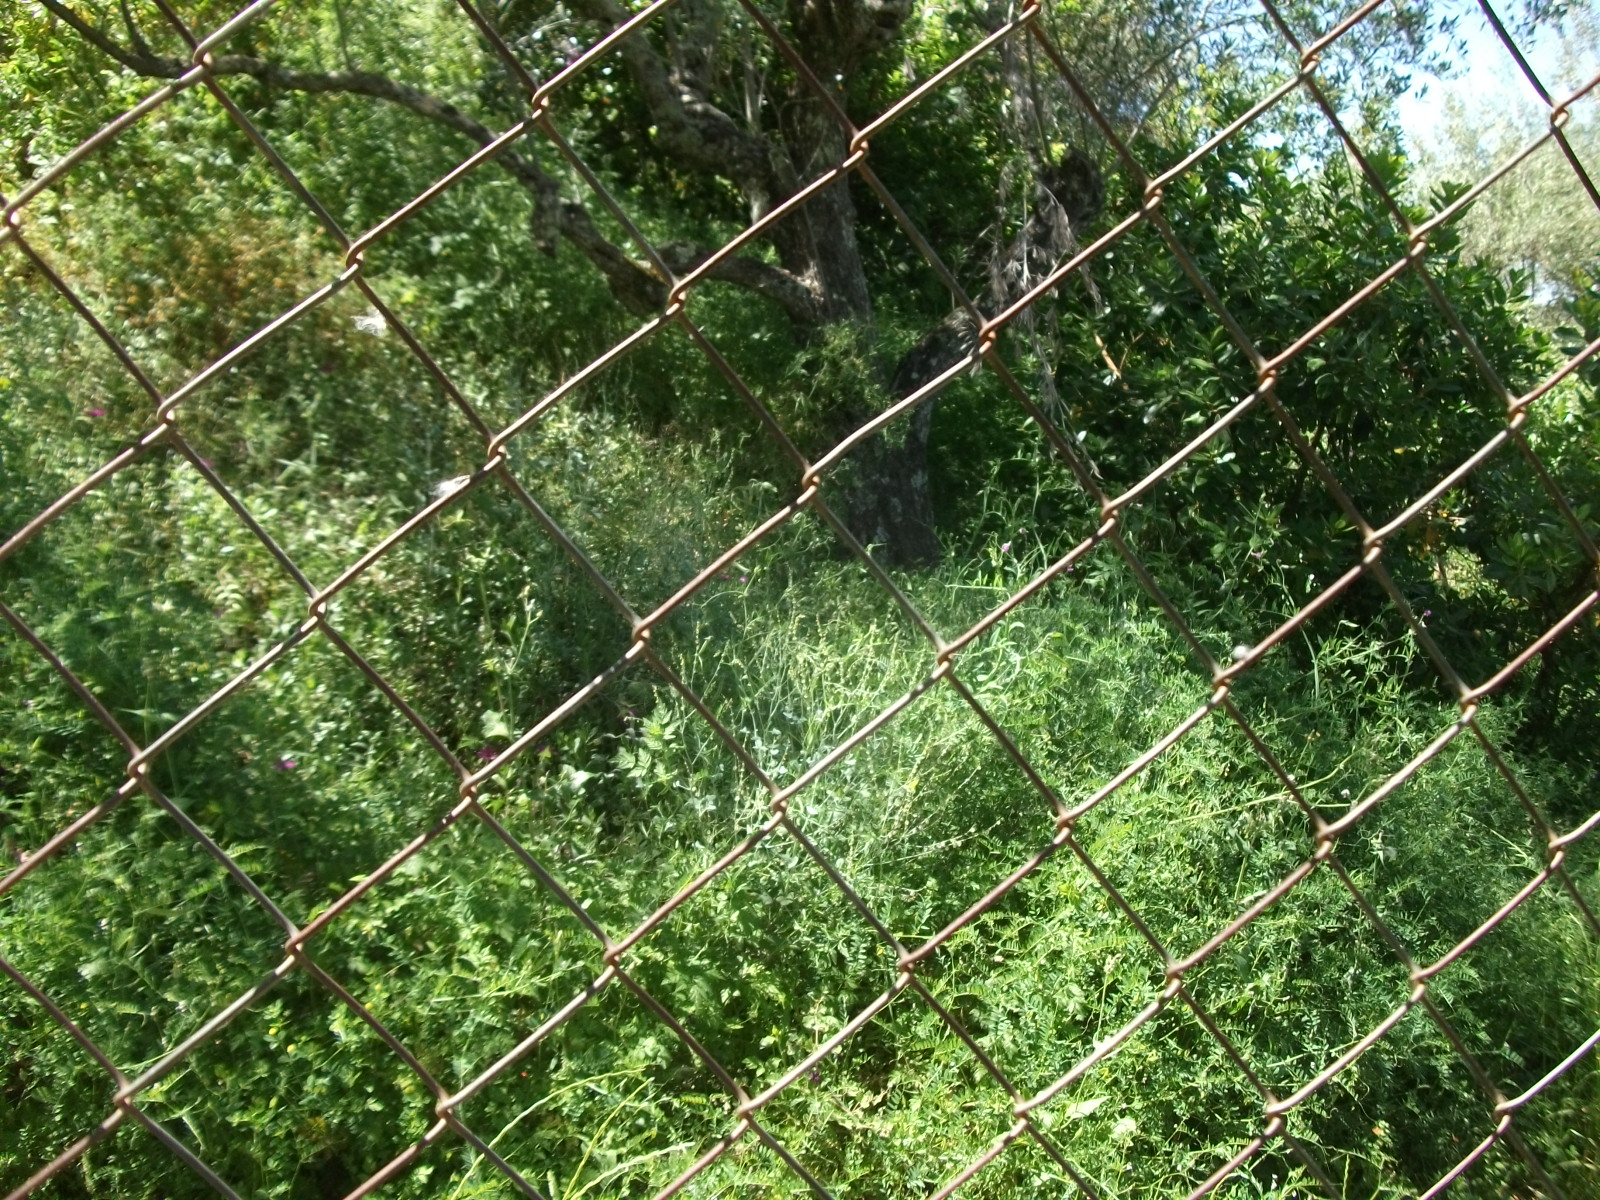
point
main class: Cropland
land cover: Olive groves
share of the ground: 10 - 25 %
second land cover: Spontaneously vegetated surfaces
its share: > 75 %
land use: Agriculture (excluding fallow land and kitchen gardens)
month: May
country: ES
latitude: 37.9346
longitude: -6.6228
